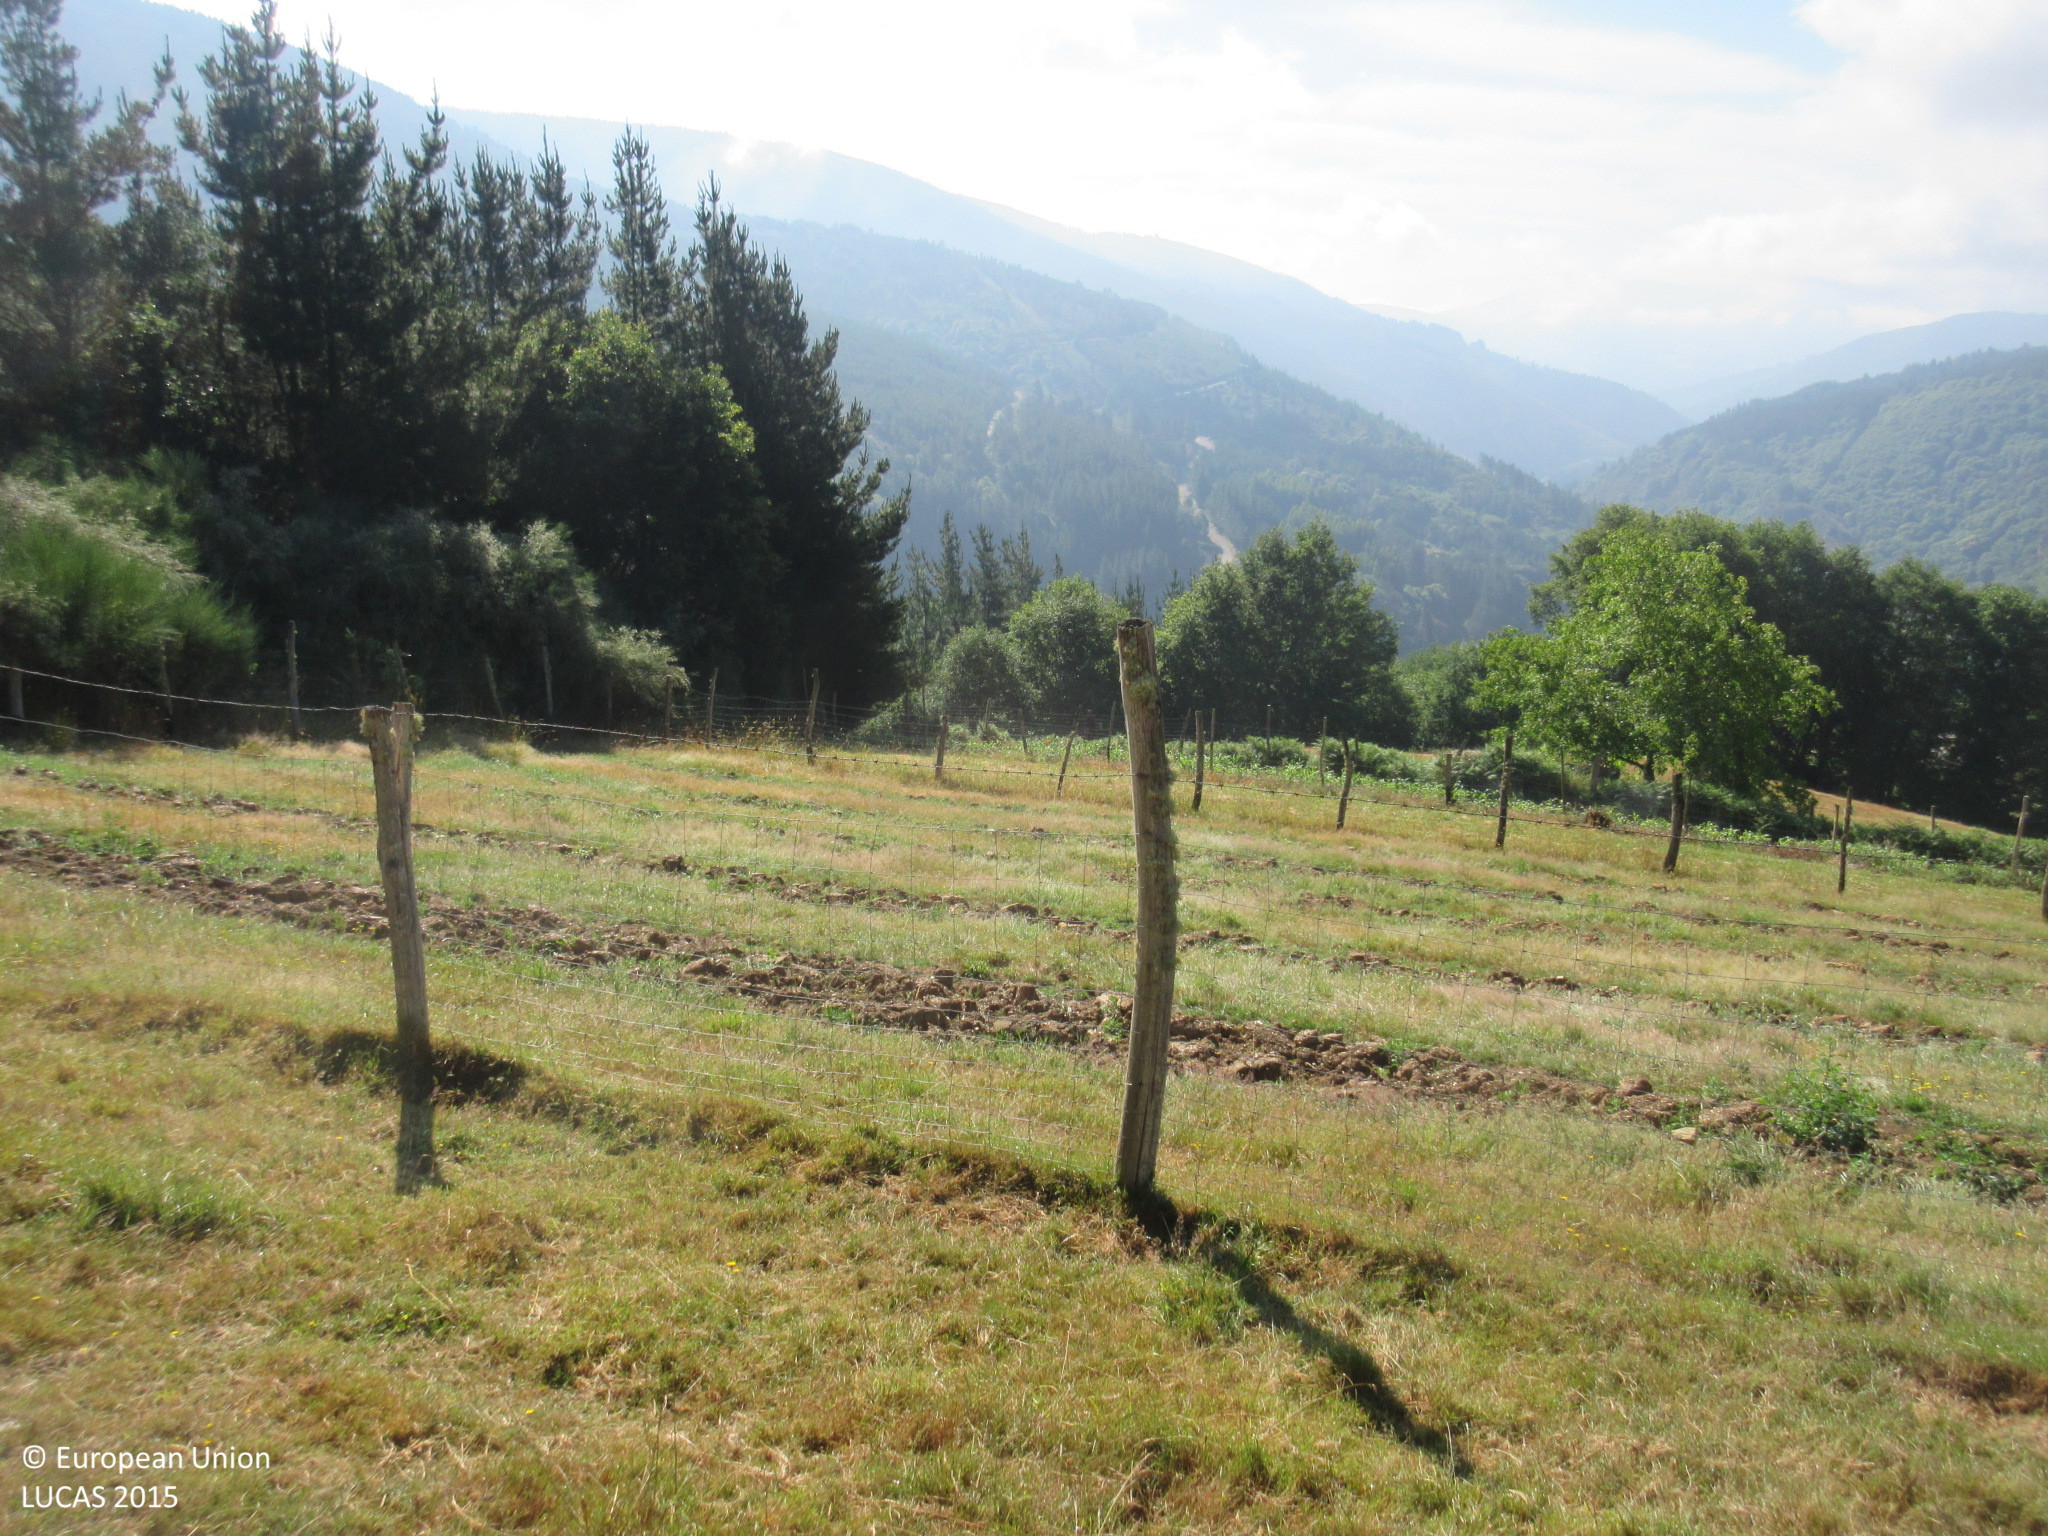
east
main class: Grassland
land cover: Grassland without tree/shrub cover
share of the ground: > 75 %
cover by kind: herbaceous plants 100 %
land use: Agriculture (excluding fallow land and kitchen gardens)
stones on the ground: 10 - 25 %
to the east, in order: Grassland without tree/shrub cover; Fences; Grassland without tree/shrub cover; Fences; Broadleaved woodland; Paved roads, cycling and walking lanes; Broadleaved woodland
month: June
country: ES
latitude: 43.0956
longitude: -7.0307
